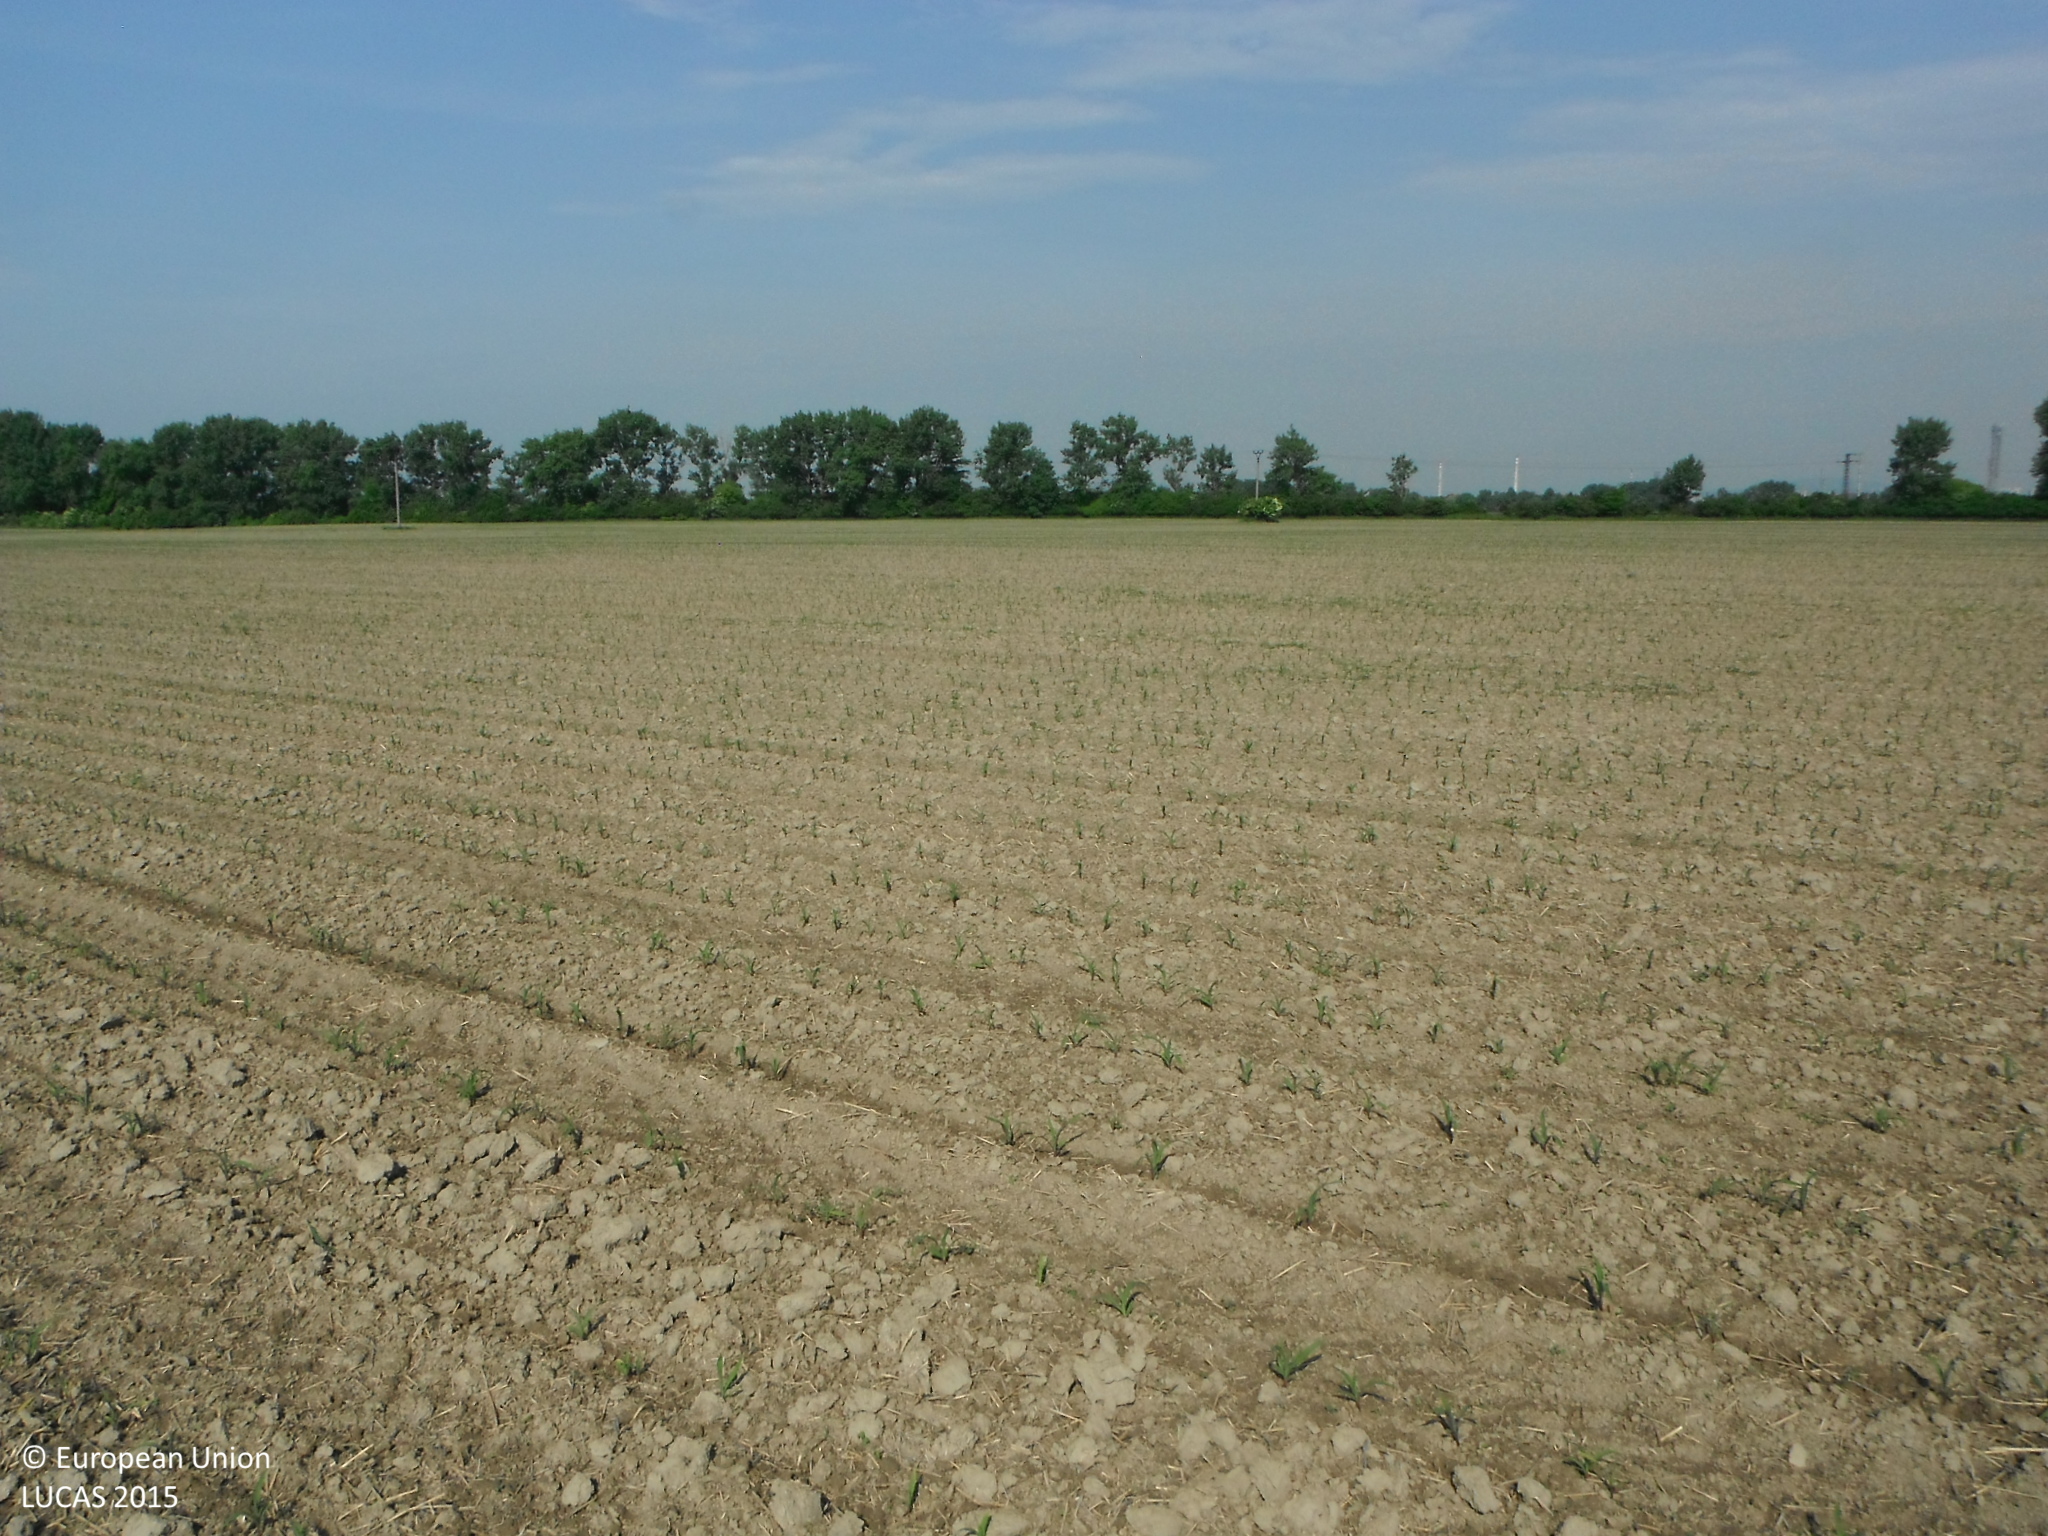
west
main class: Cropland
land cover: Maize
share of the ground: < 10 %
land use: Agriculture (excluding fallow land and kitchen gardens)
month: May
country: SK
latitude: 48.0951
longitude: 17.2187
